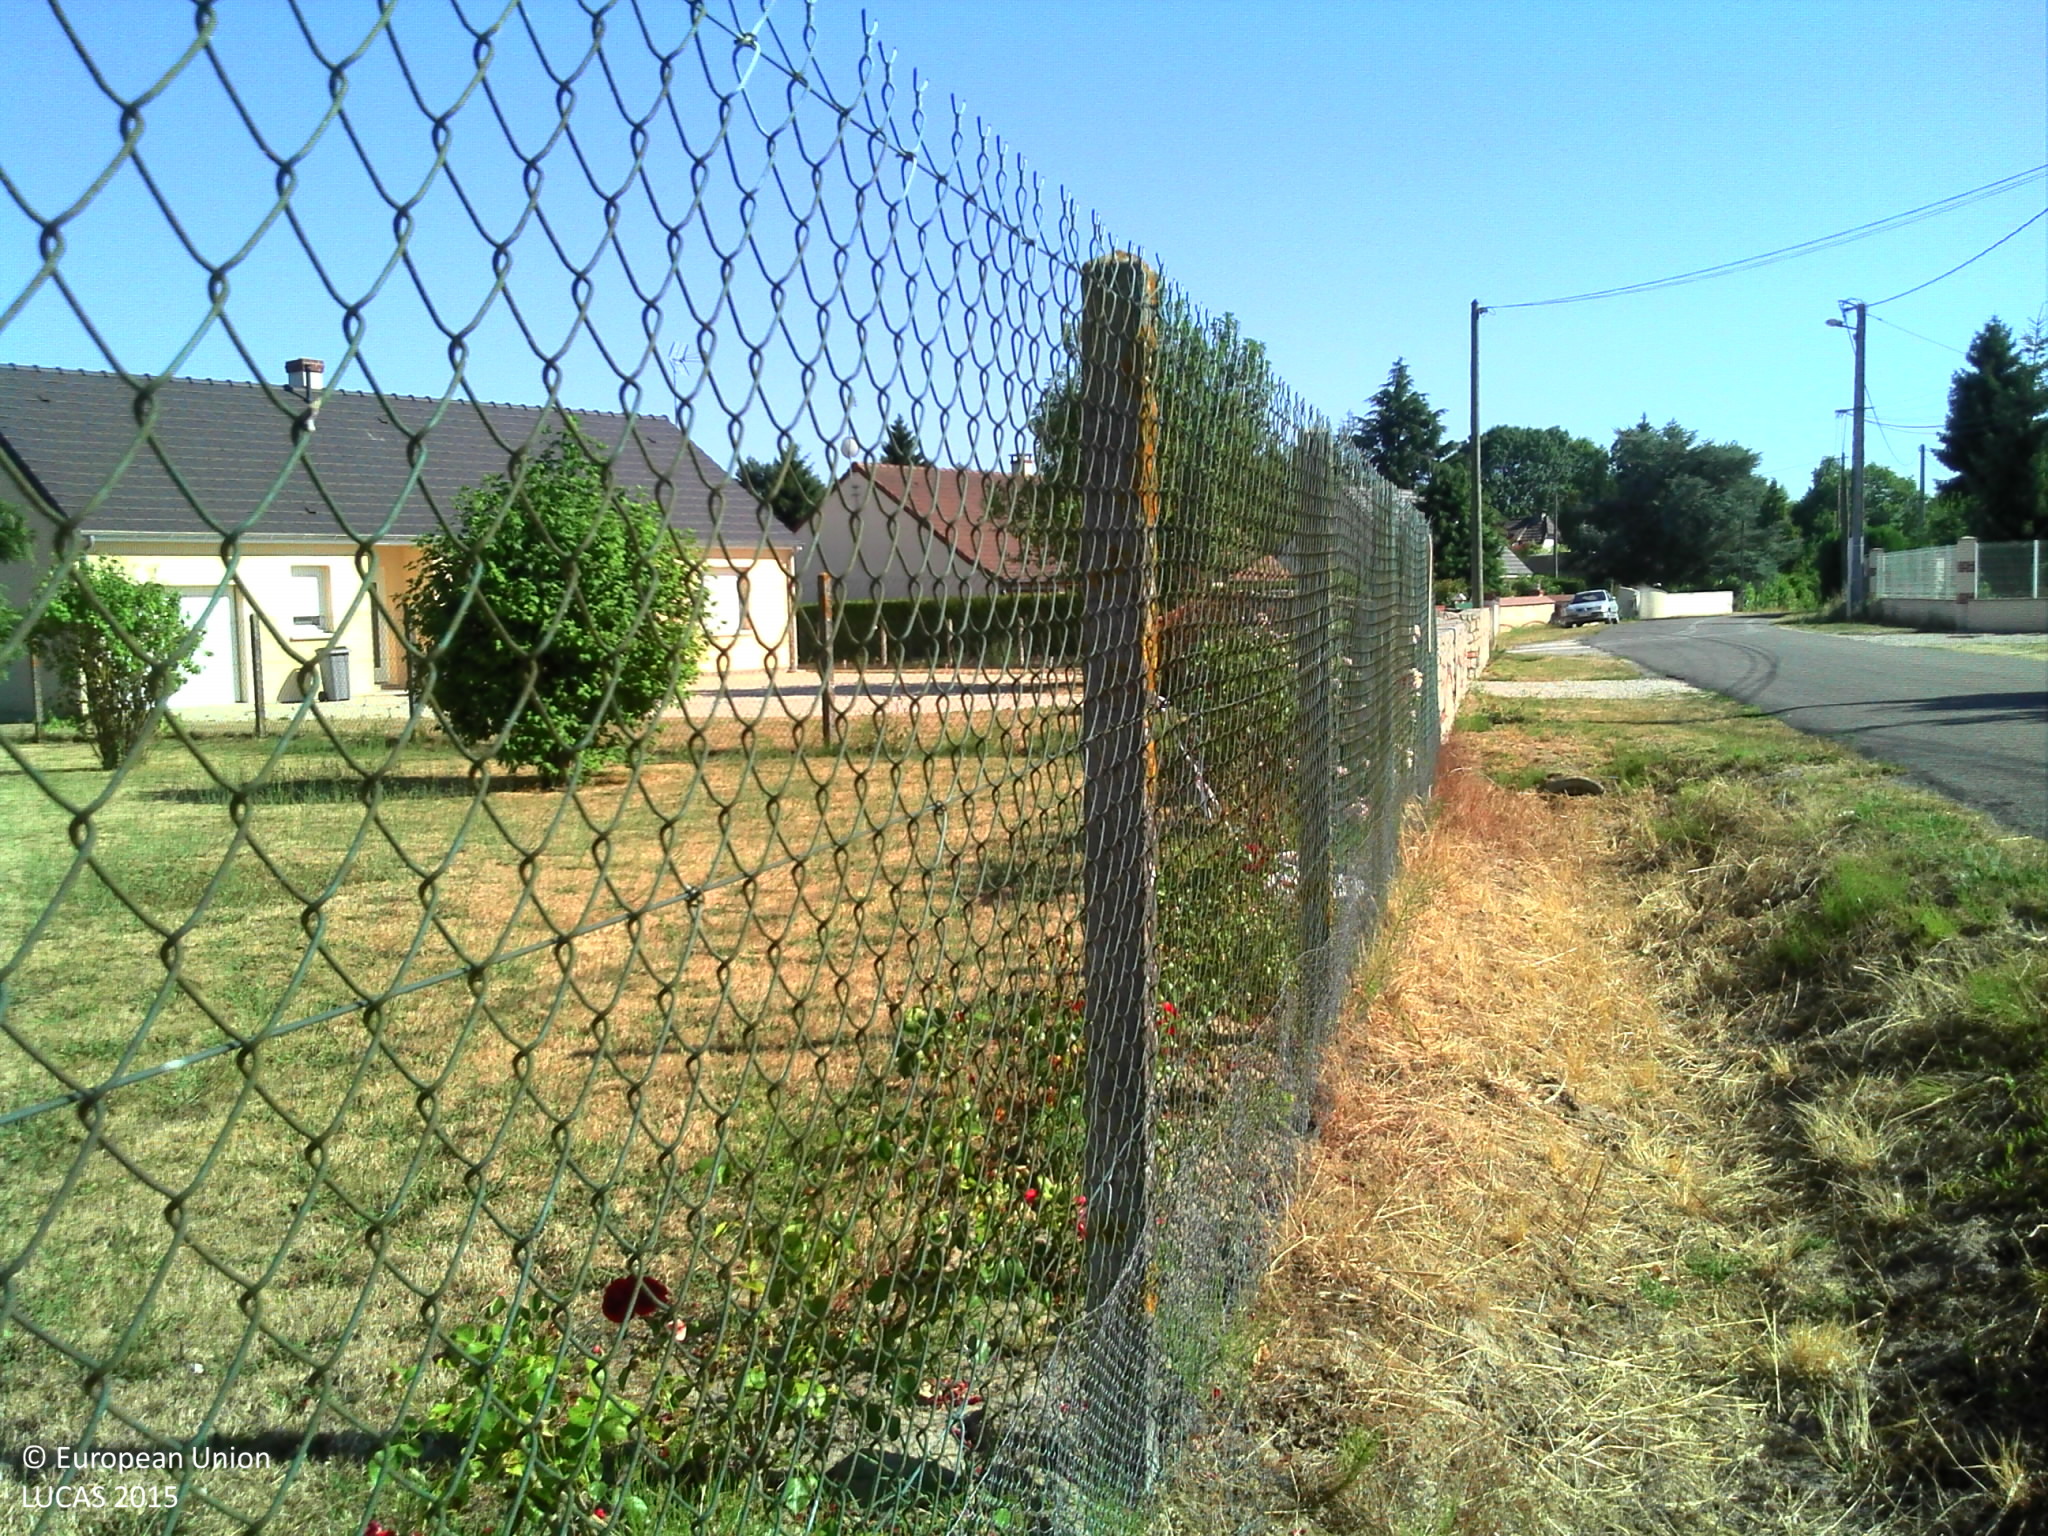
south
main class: Grassland
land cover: Grassland with sparse tree/shrub cover
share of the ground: > 75 %
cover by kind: herbaceous plants 95 %, coniferous forest trees 5 %
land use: Residential
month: July
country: FR
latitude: 47.8965
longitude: 2.5137
